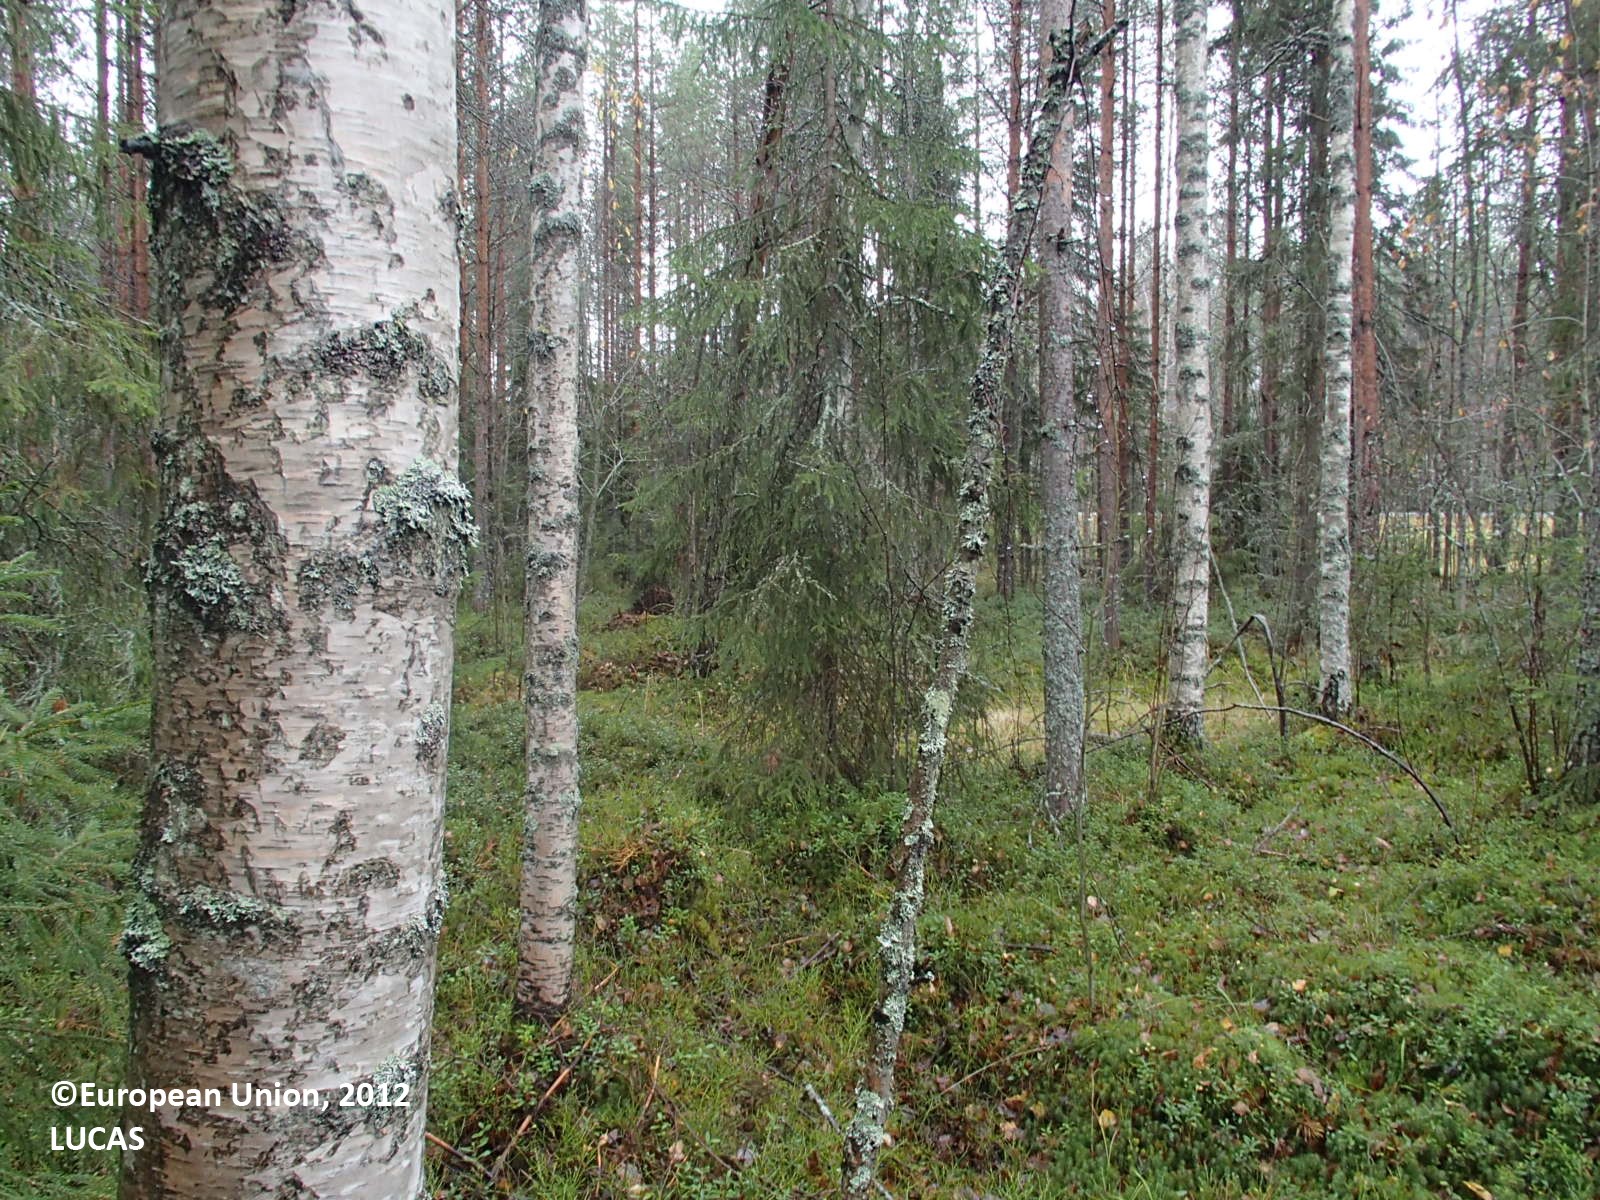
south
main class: Woodland
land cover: Pine dominated mixed woodland
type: boreal forest
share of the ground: > 75 %
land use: Forestry
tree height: > 5 m
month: October
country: FI
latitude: 63.8597
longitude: 26.8340
